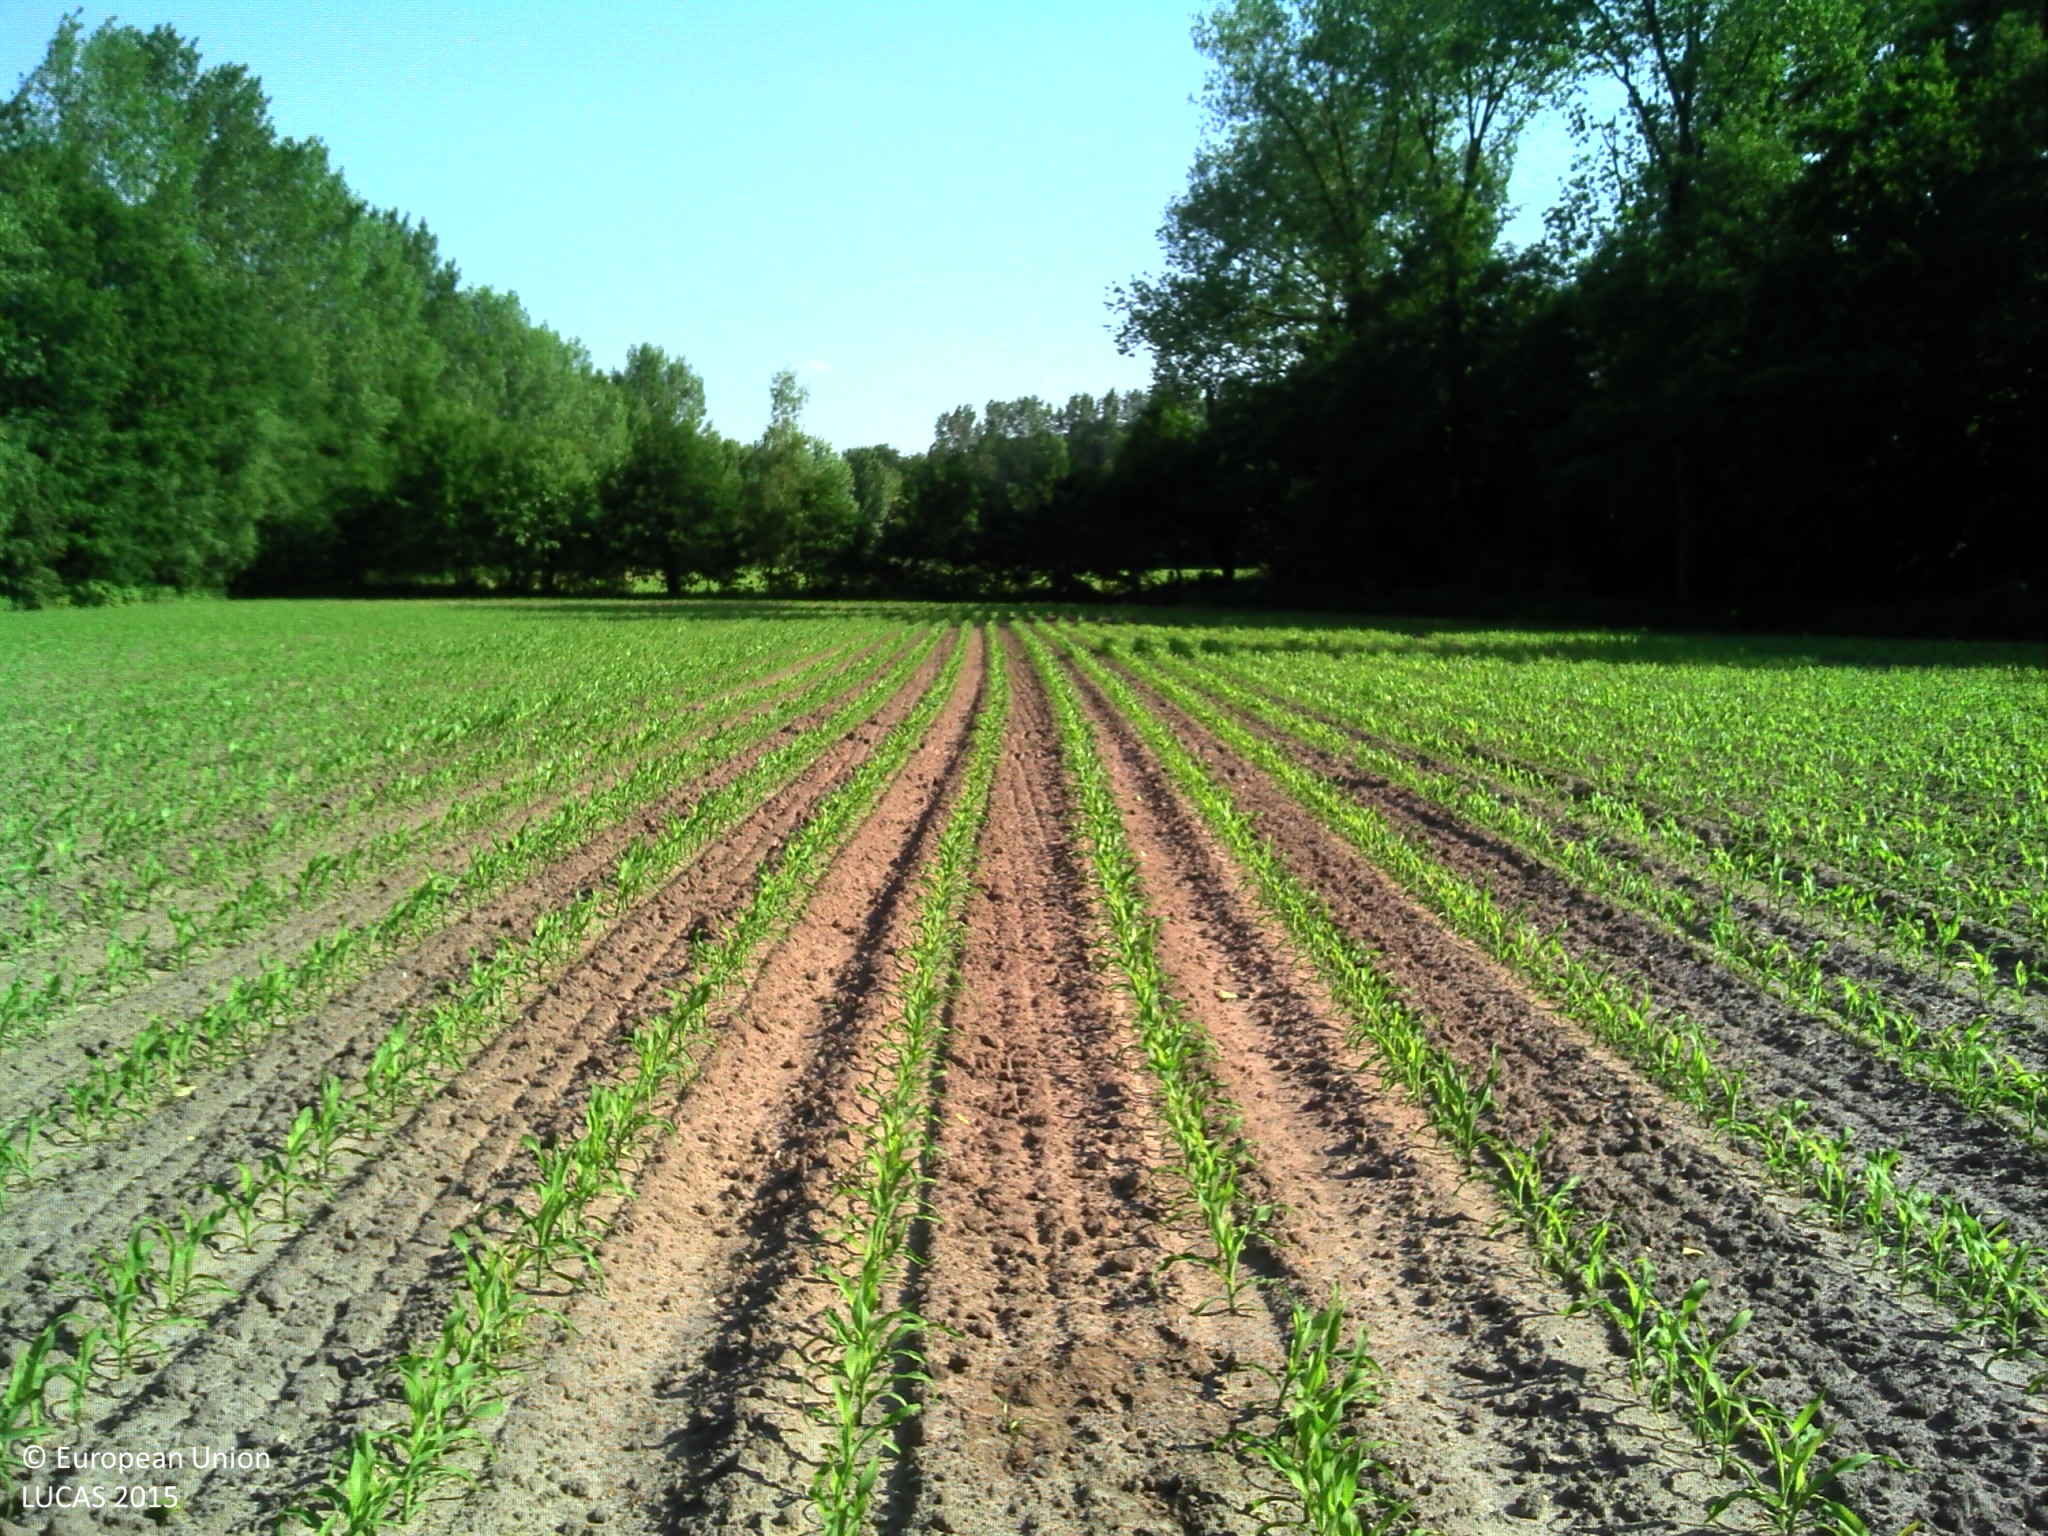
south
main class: Cropland
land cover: Maize
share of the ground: 10 - 25 %
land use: Agriculture (excluding fallow land and kitchen gardens)
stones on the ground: < 10 %
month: June
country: BE
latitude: 51.0086
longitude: 3.8222
